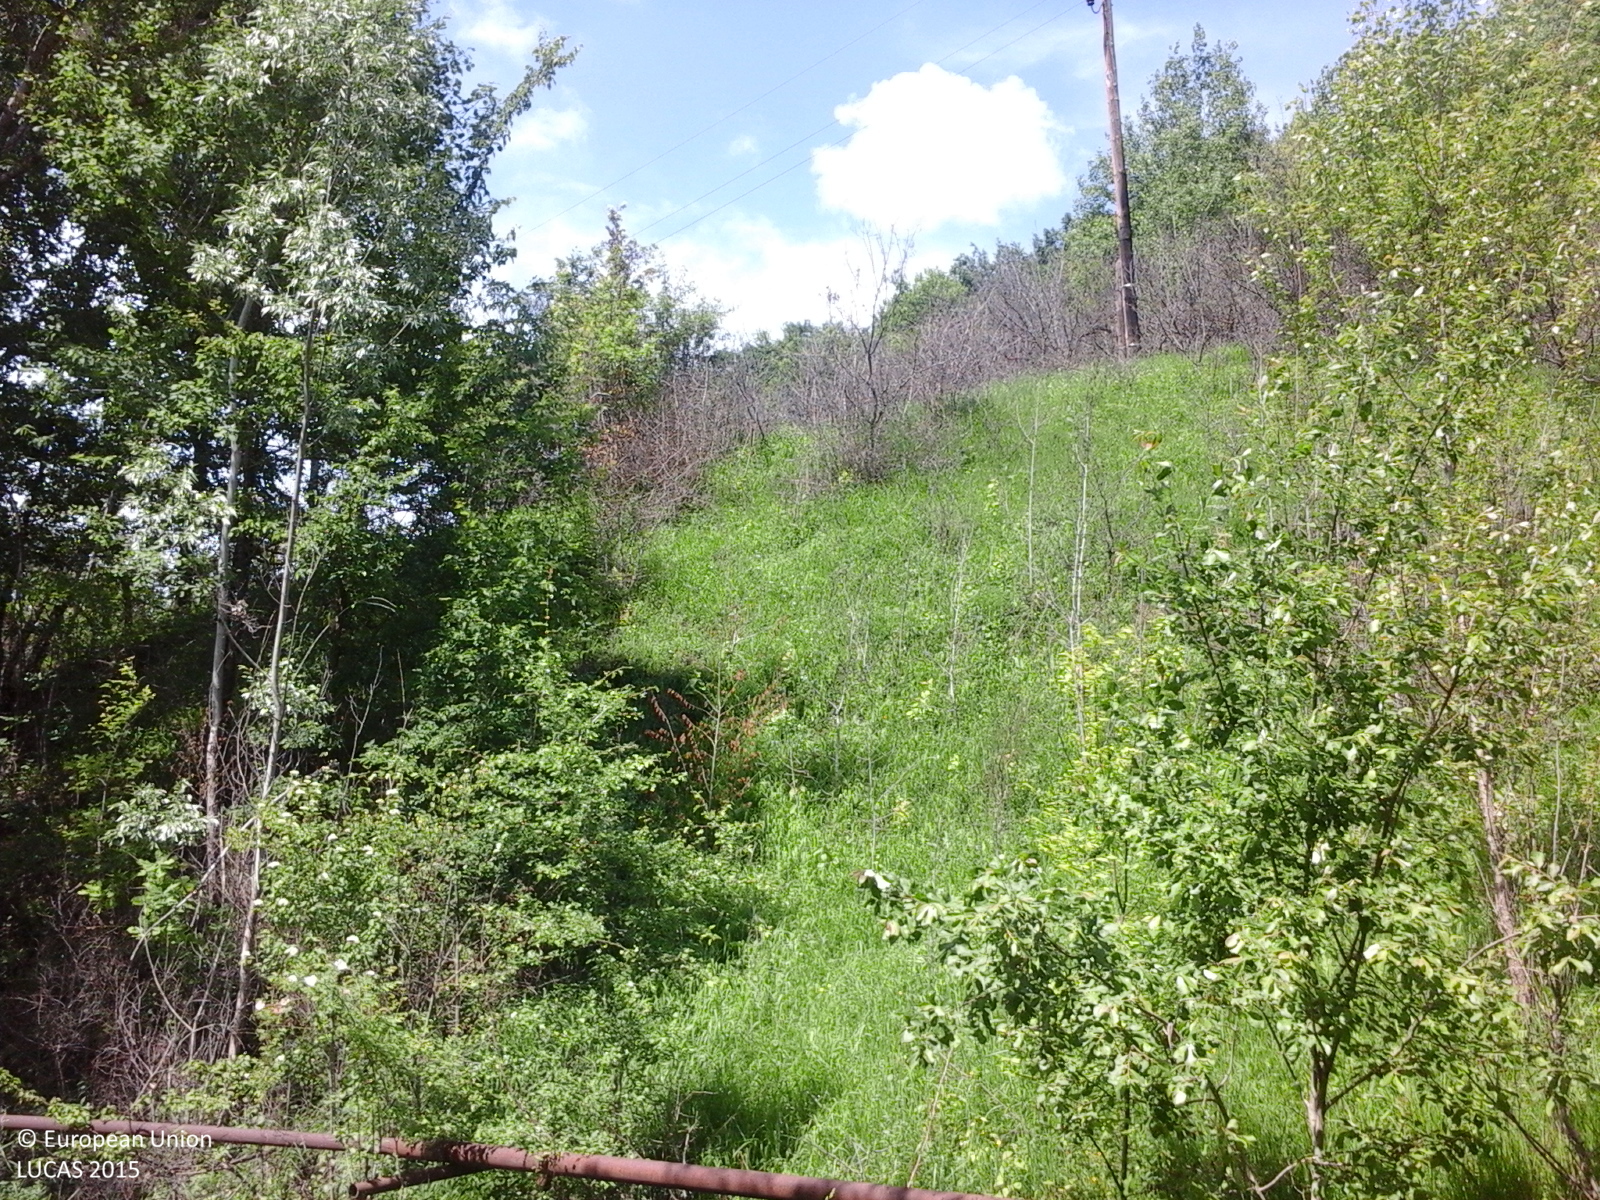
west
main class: Woodland
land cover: Broadleaved woodland
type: beech forest
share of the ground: > 75 %
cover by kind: broadleaved forest trees 90 %, shrubs 5 %, herbaceous plants 5 %
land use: Forestry
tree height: > 5 m
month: May
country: RO
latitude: 45.2338
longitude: 26.2032
